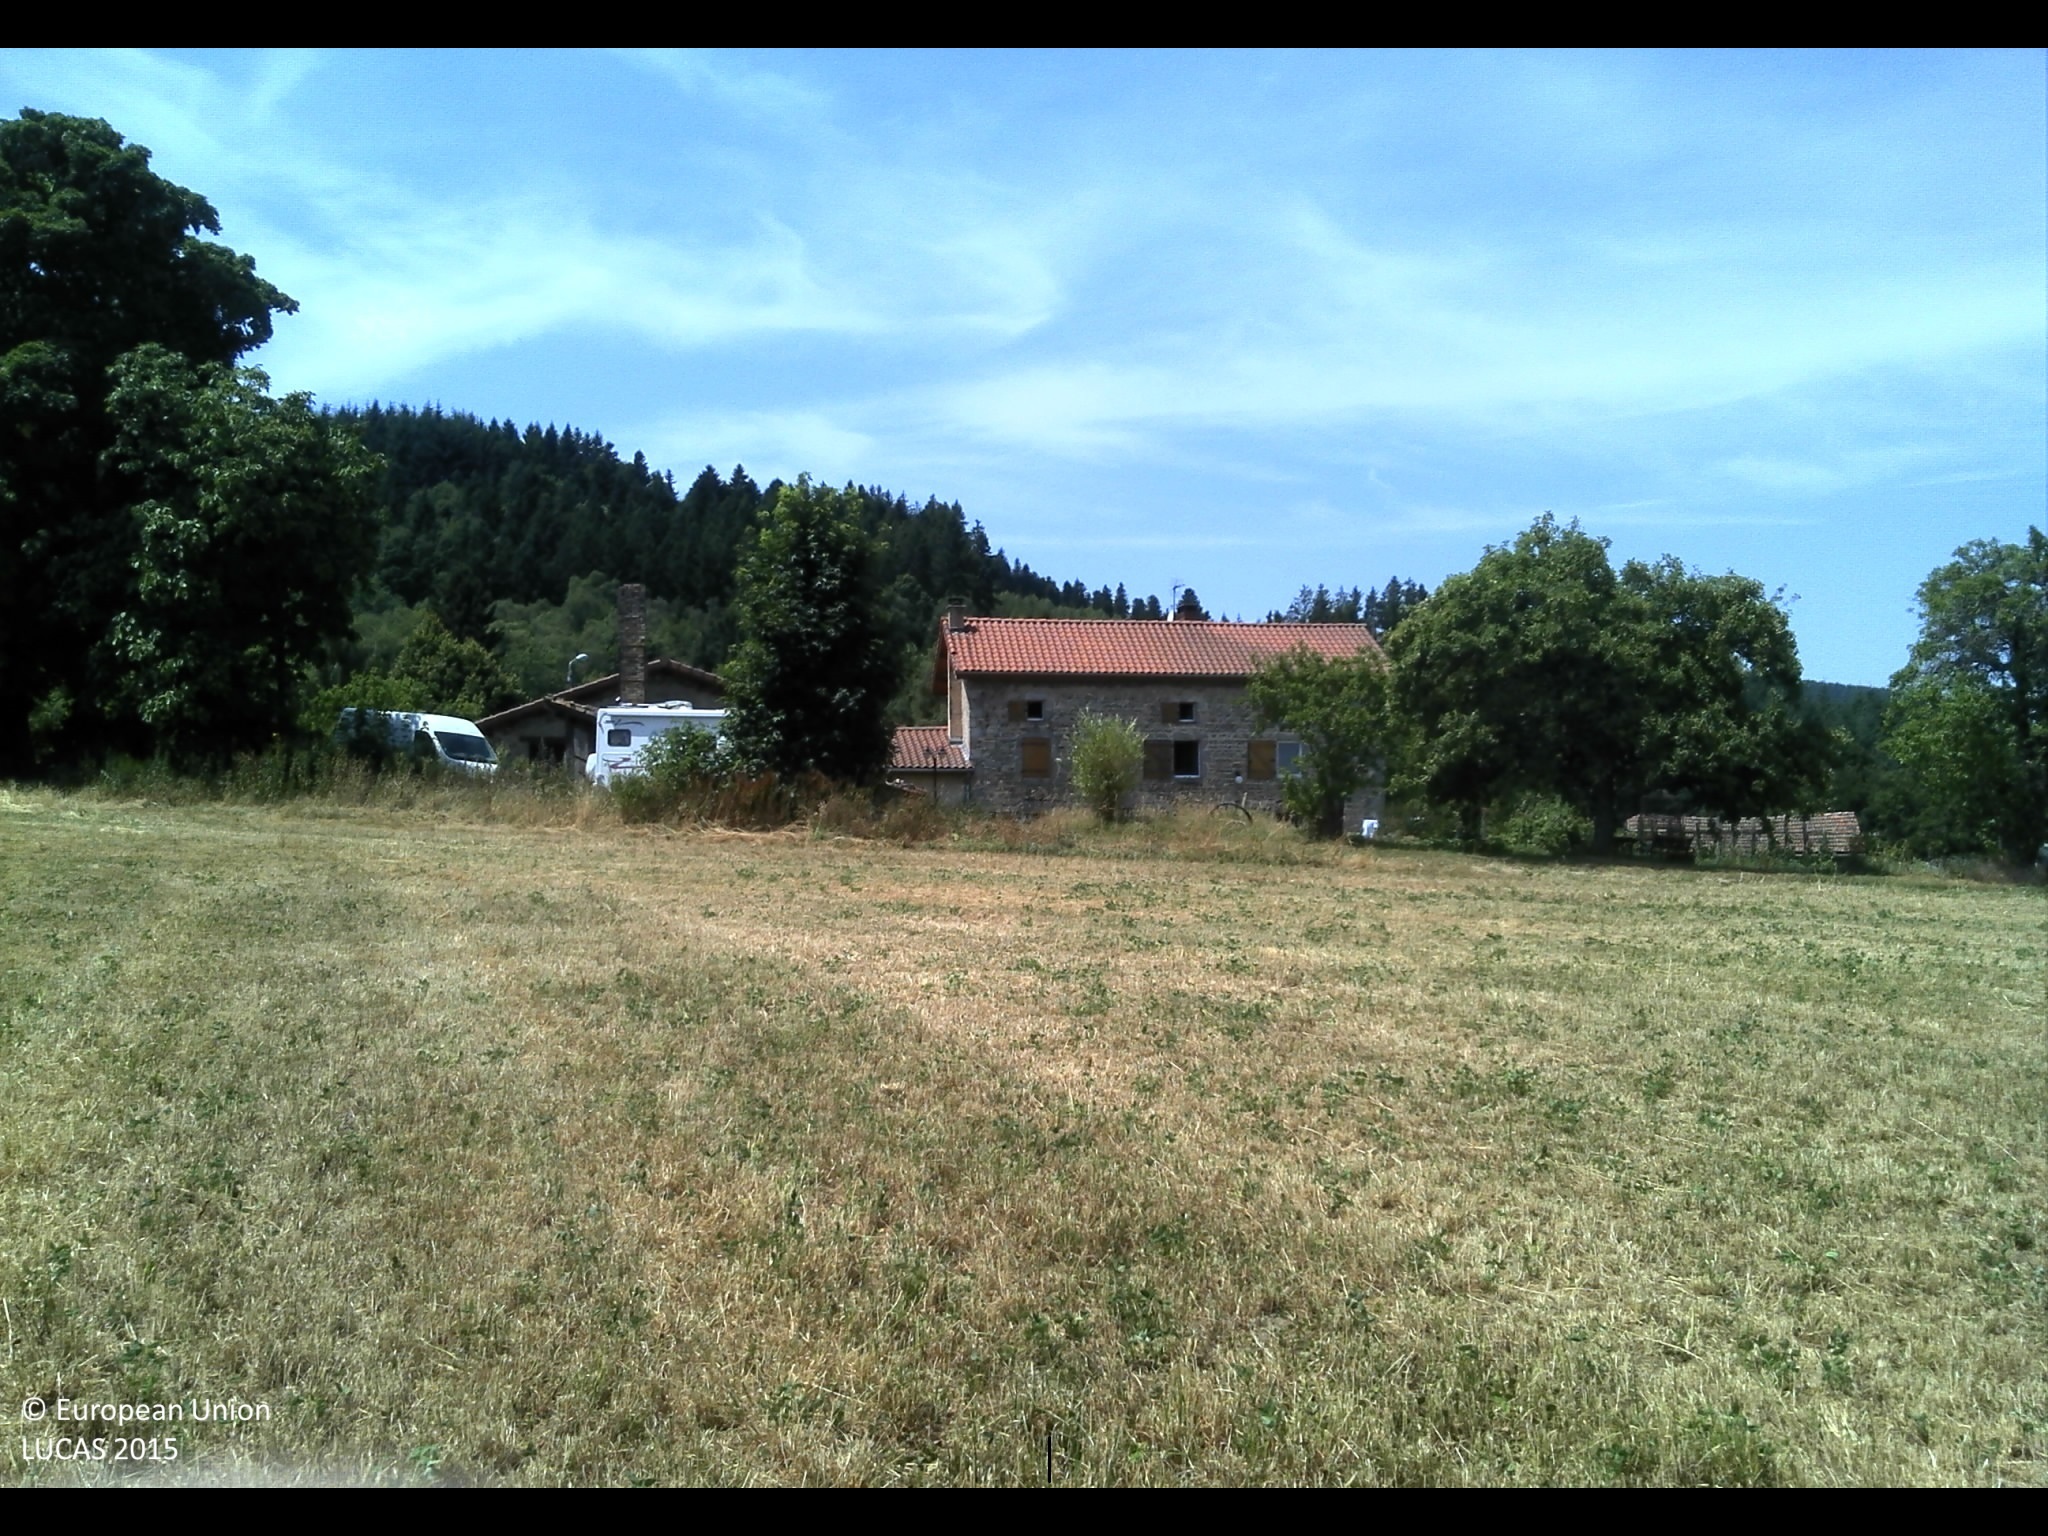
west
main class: Cropland
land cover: Temporary grasslands
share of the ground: > 75 %
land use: Agriculture (excluding fallow land and kitchen gardens)
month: July
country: FR
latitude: 45.8062
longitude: 3.7350
